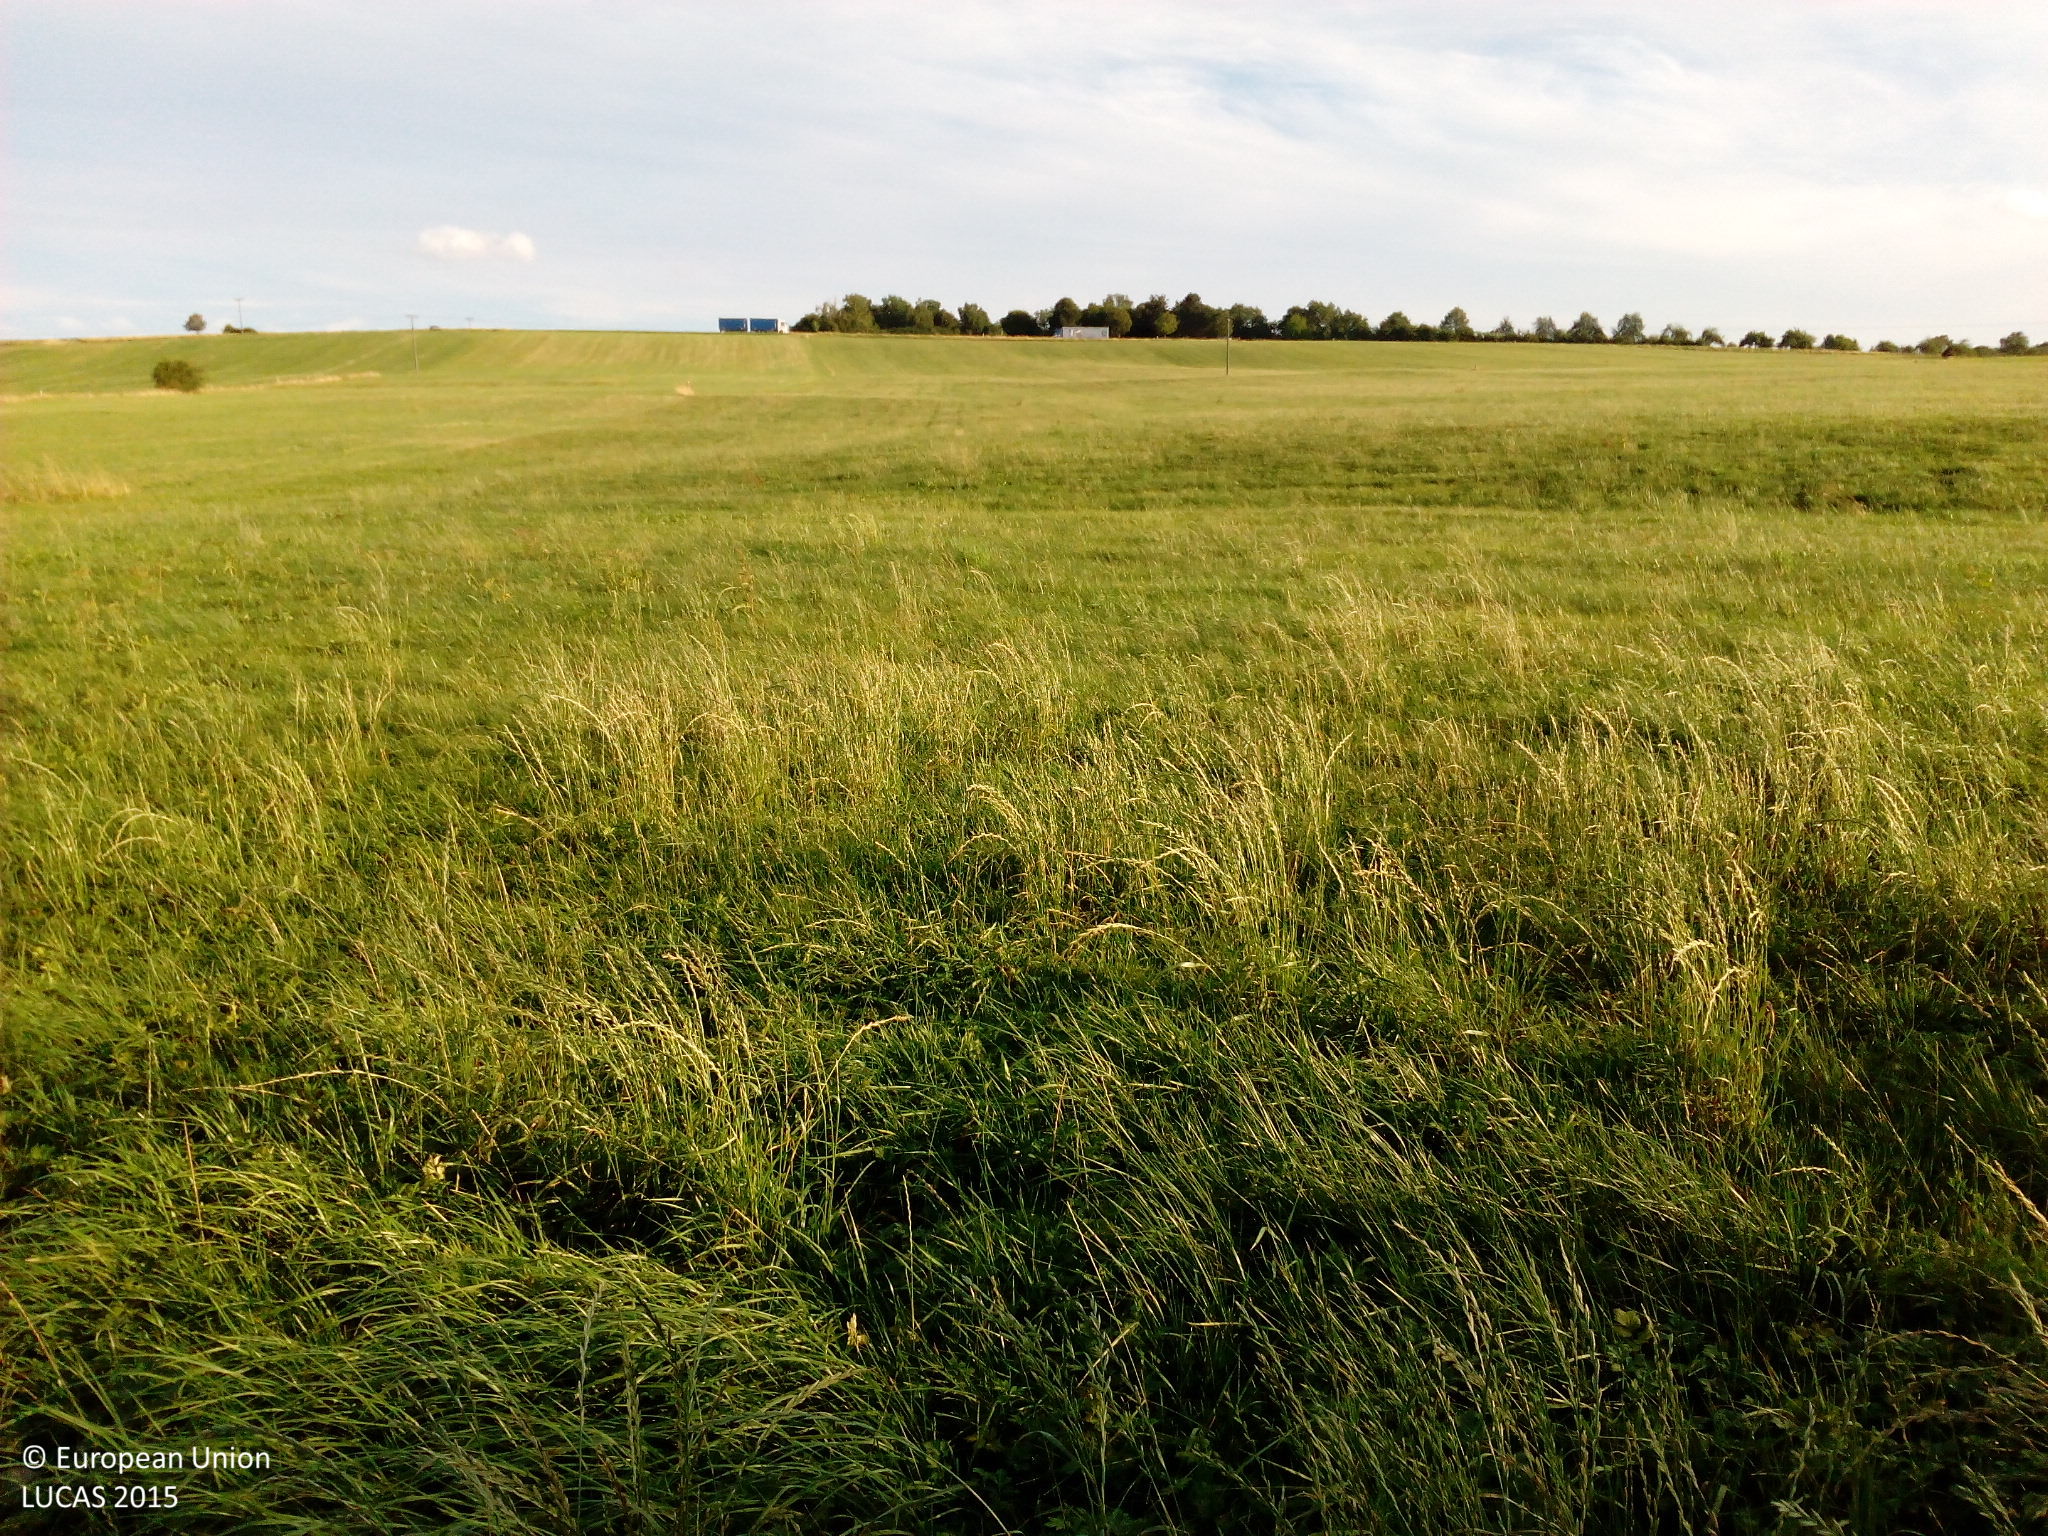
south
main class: Grassland
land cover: Grassland without tree/shrub cover
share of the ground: > 75 %
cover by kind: herbaceous plants 100 %
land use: Agriculture (excluding fallow land and kitchen gardens)
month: July
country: DE
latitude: 48.9429
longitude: 10.2593
